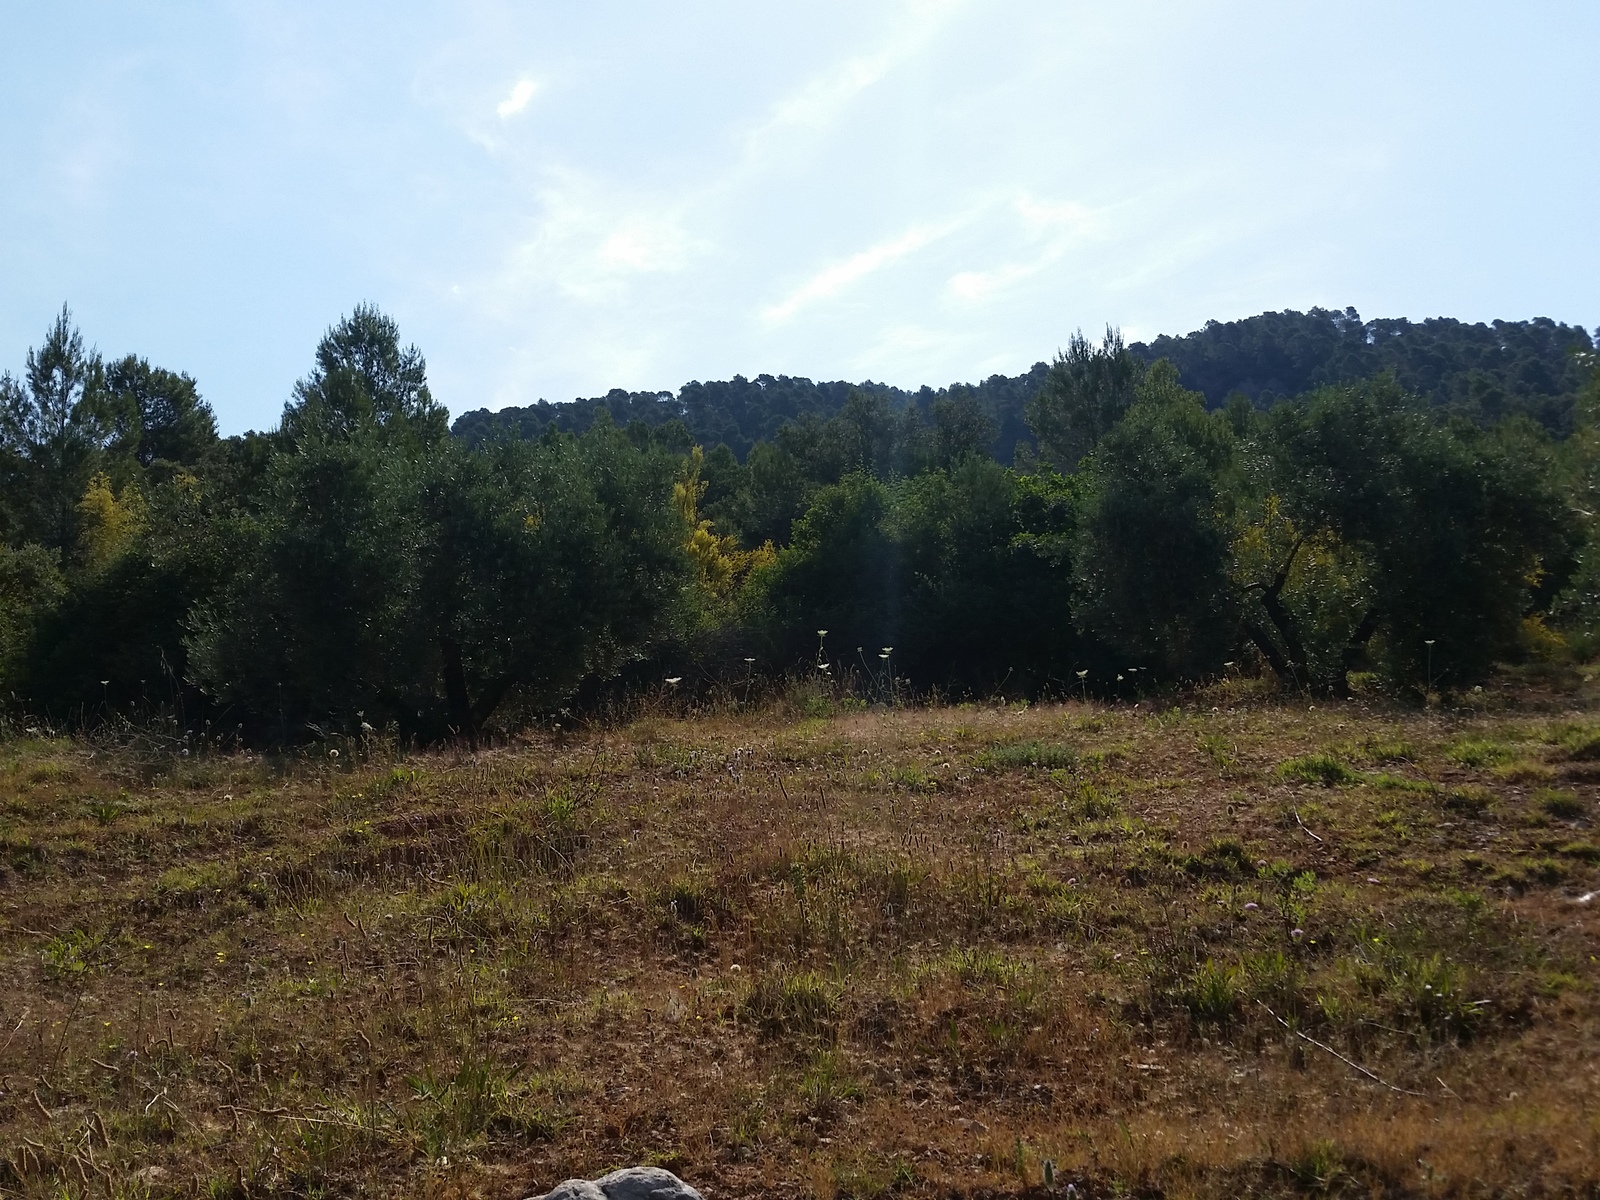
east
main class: Cropland
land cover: Olive groves
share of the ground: 50 - 75 %
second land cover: Grassland without tree/shrub cover
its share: 25 - 50 %
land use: Agriculture (excluding fallow land and kitchen gardens)
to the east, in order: Olive groves; Grassland without tree/shrub cover; Shrubland with sparse tree cover; Tracks; Pine dominated coniferous woodland; Shrubland with sparse tree cover
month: June
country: ES
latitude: 38.4163
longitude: -2.5394
